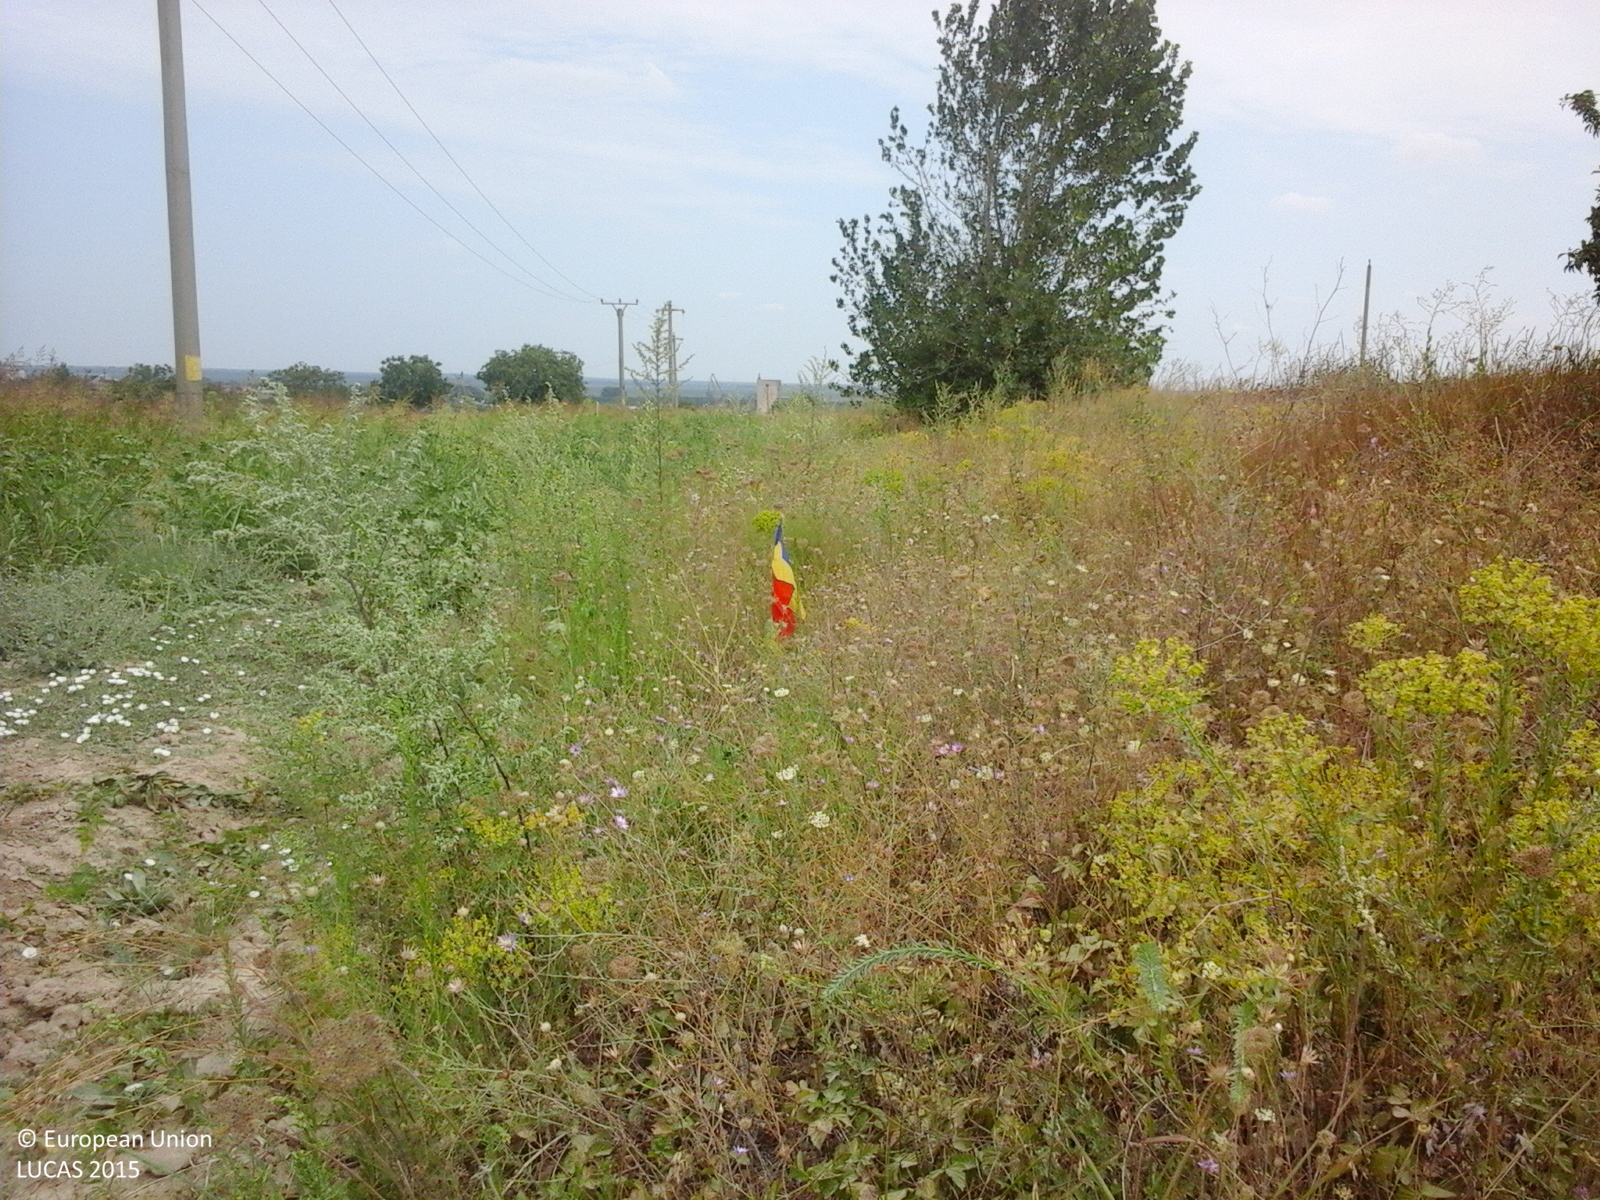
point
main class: Grassland
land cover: Spontaneously vegetated surfaces
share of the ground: > 75 %
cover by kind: herbaceous plants 100 %
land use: Fallow land
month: August
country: RO
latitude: 45.0733
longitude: 29.0886
